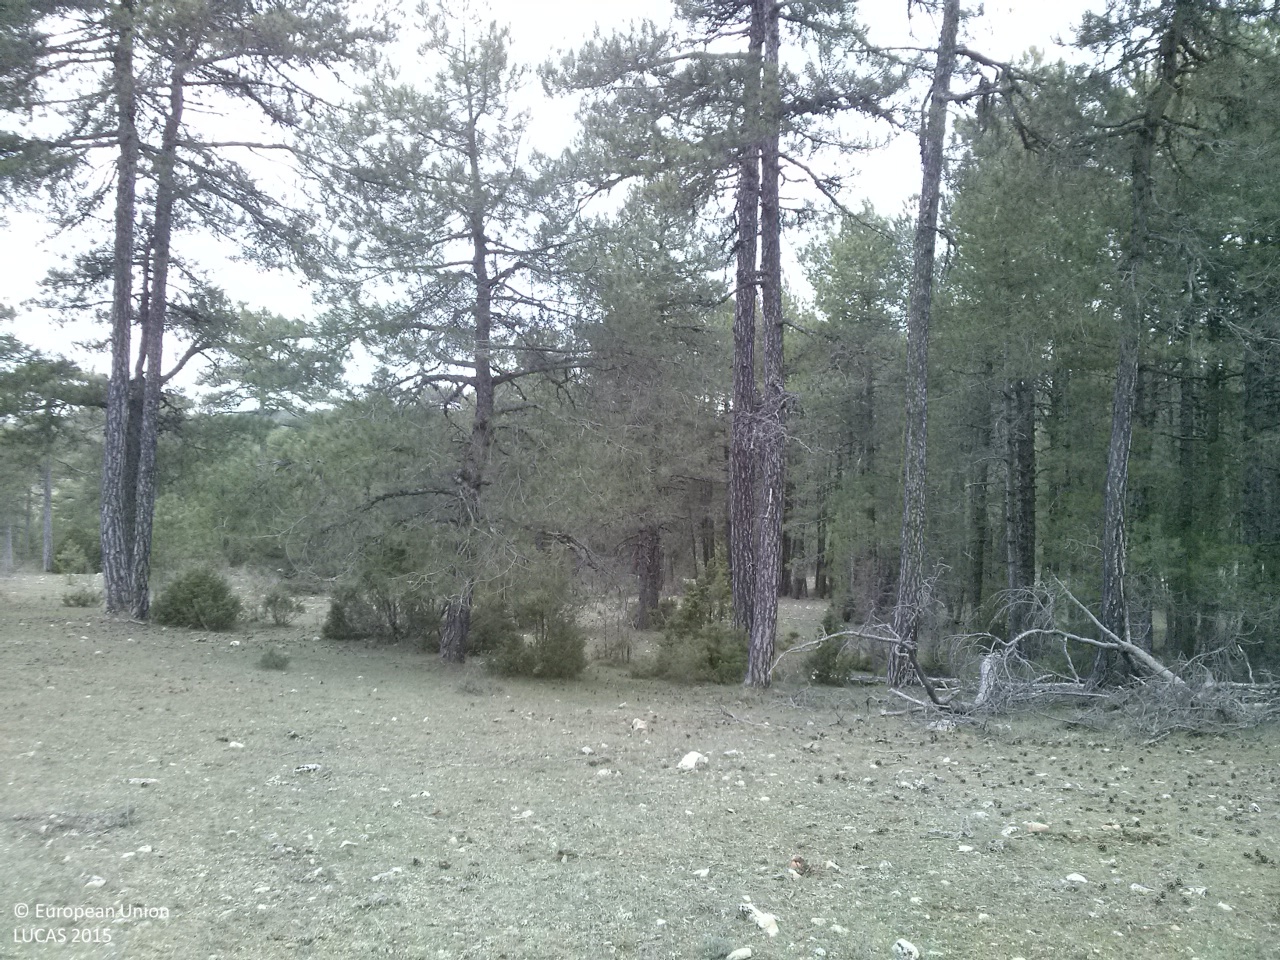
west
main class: Woodland
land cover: Pine dominated coniferous woodland
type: coniferous forest of the mediterranean region
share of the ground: 25 - 50 %
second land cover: Grassland without tree/shrub cover
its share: > 75 %
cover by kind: herbaceous plants 55 %, coniferous forest trees 40 %, shrubs 5 %
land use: Forestry
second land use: Agriculture (excluding fallow land and kitchen gardens)
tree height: > 5 m
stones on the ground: 10 - 25 %
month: April
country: ES
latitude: 40.2797
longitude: -1.9781
